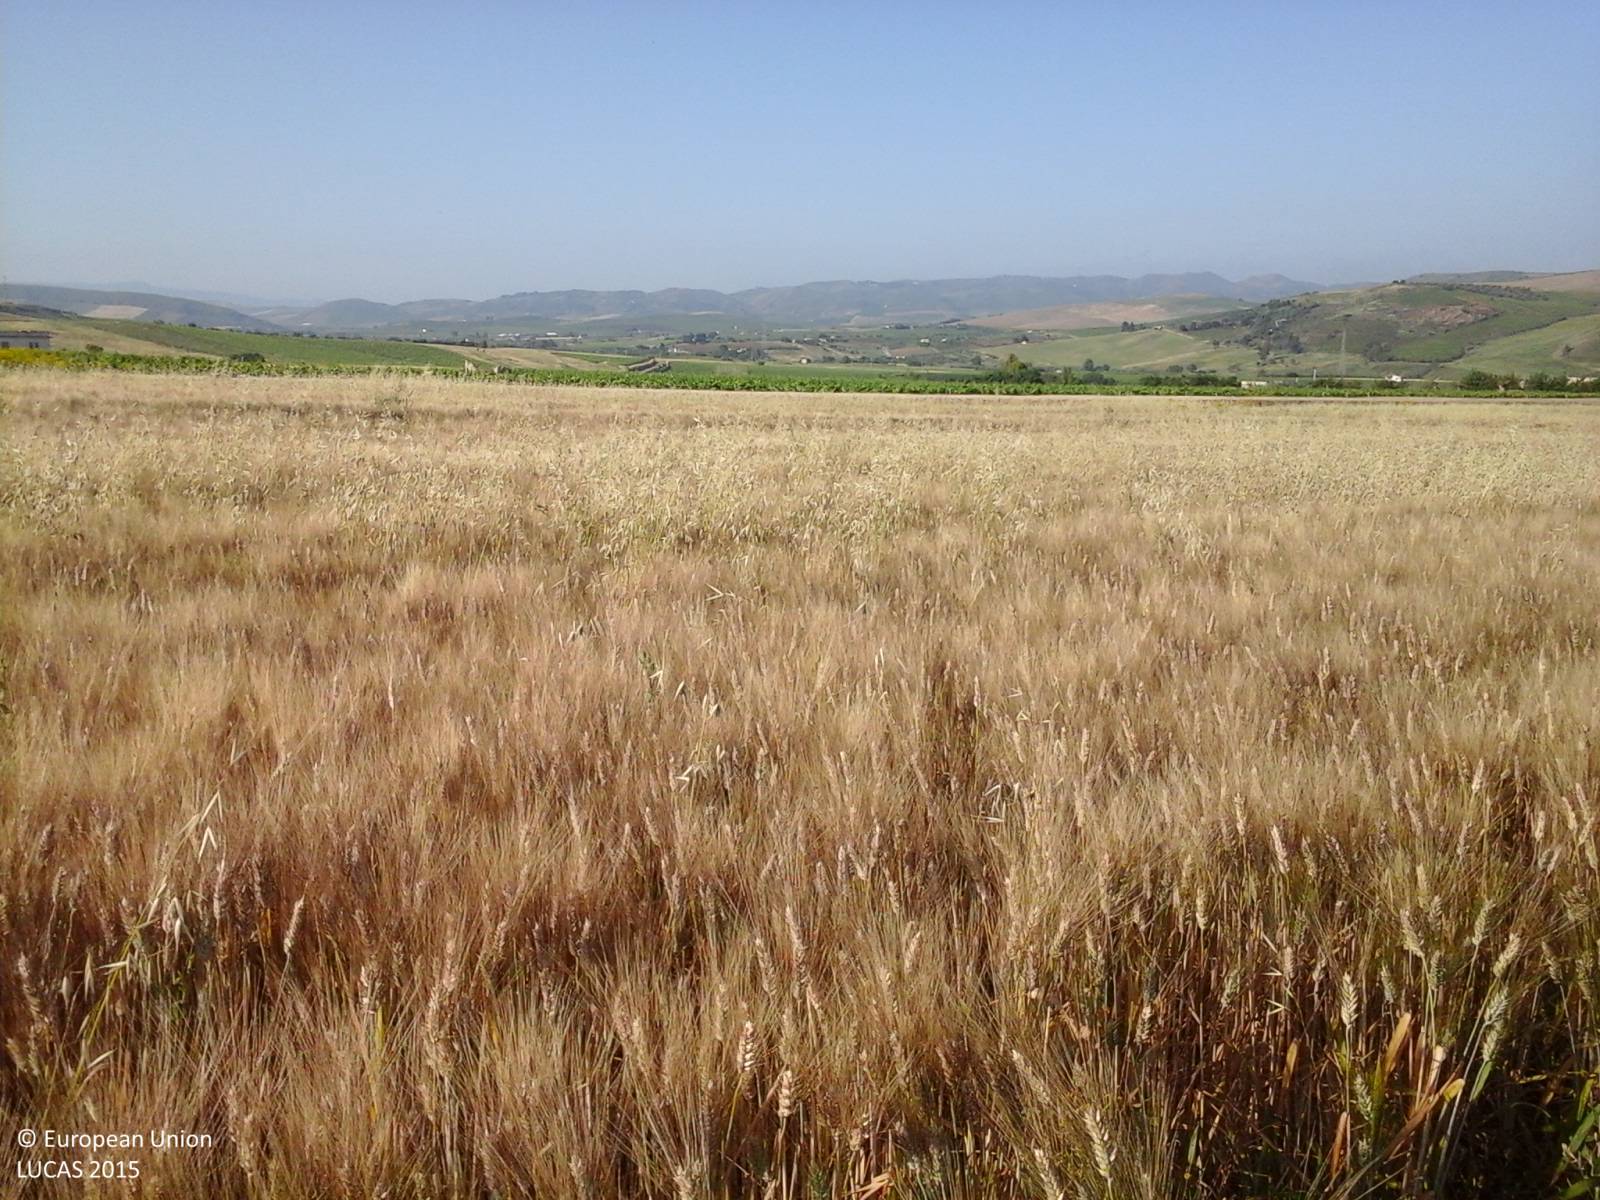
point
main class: Cropland
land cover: Durum wheat
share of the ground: > 75 %
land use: Agriculture (excluding fallow land and kitchen gardens)
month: June
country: IT
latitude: 37.9685
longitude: 13.1306
